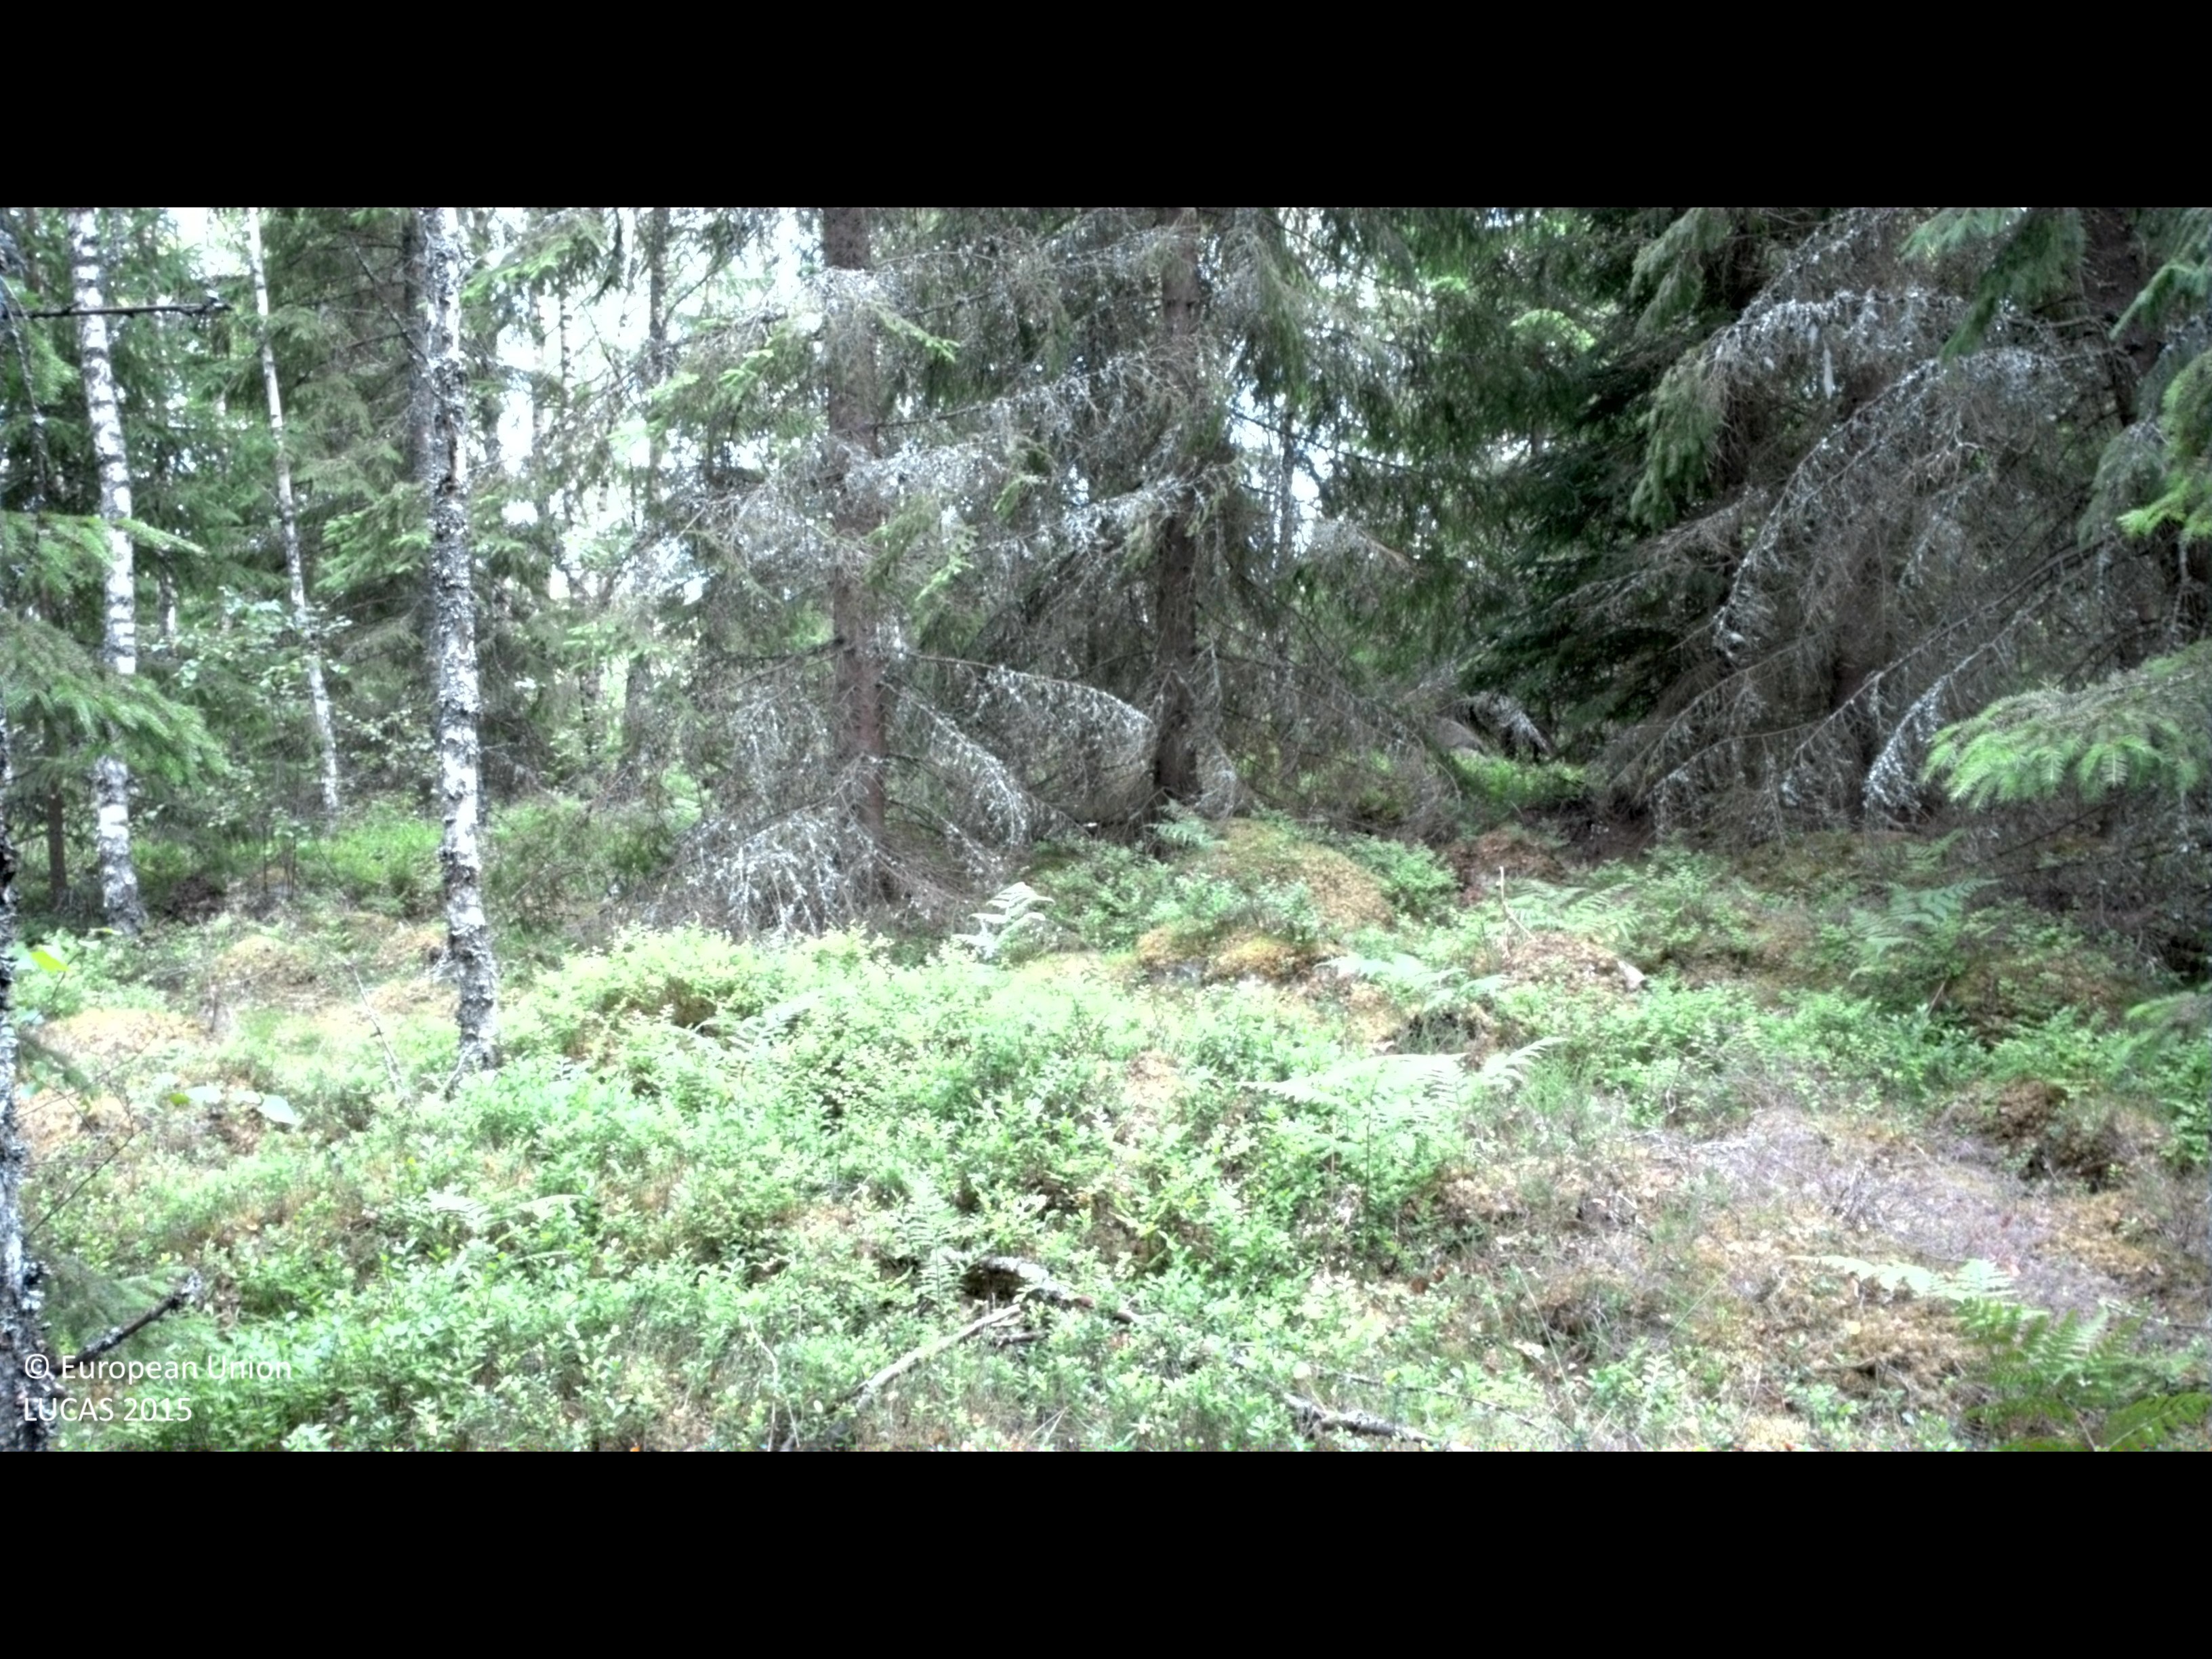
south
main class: Woodland
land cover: Spruce dominated mixed woodland
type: boreal forest
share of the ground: 50 - 75 %
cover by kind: coniferous forest trees 50 %, shrubs 25 %, broadleaved forest trees 20 %, lichens and mosses 5 %
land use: Forestry
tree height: > 5 m
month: July
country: SE
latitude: 56.5063
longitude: 14.4657
